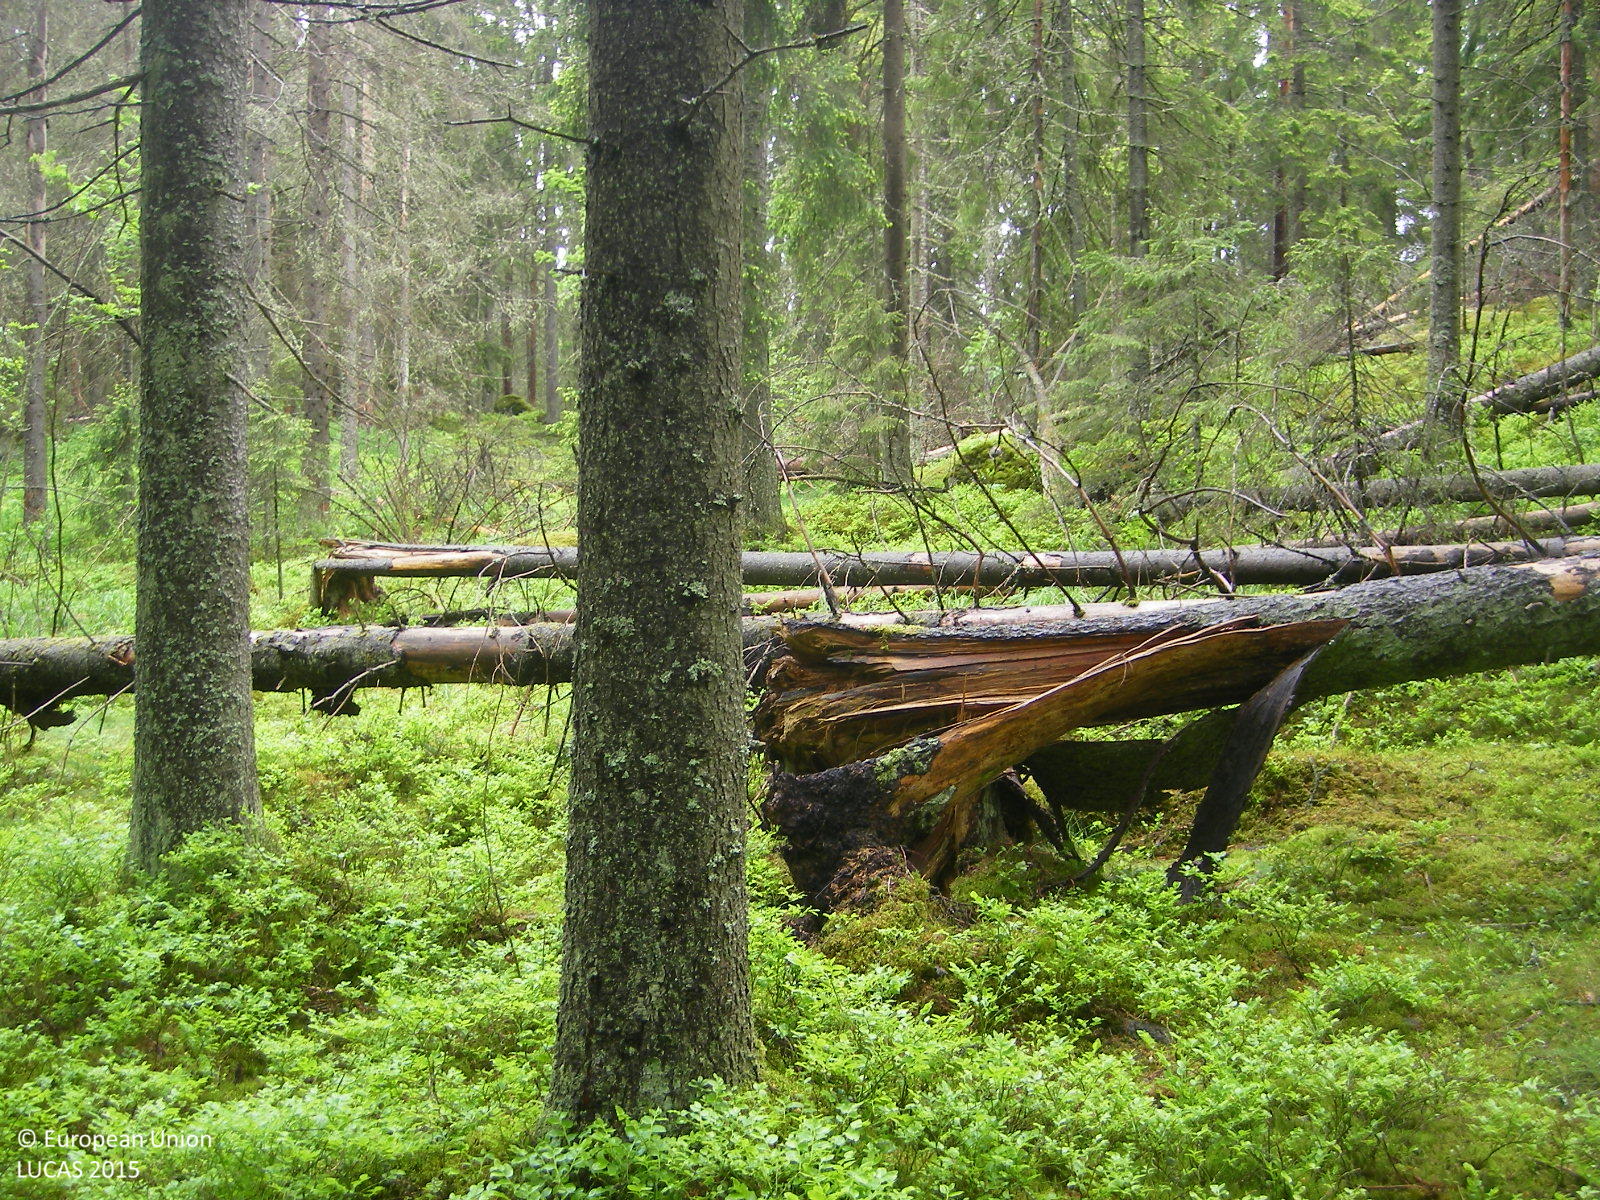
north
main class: Woodland
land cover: Spruce dominated coniferous woodland
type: boreal forest
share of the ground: > 75 %
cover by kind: coniferous forest trees 75 %, shrubs 15 %, lichens and mosses 10 %
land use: Amenities, museums, leisure
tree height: > 5 m
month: June
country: FI
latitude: 60.3237
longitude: 24.6881
